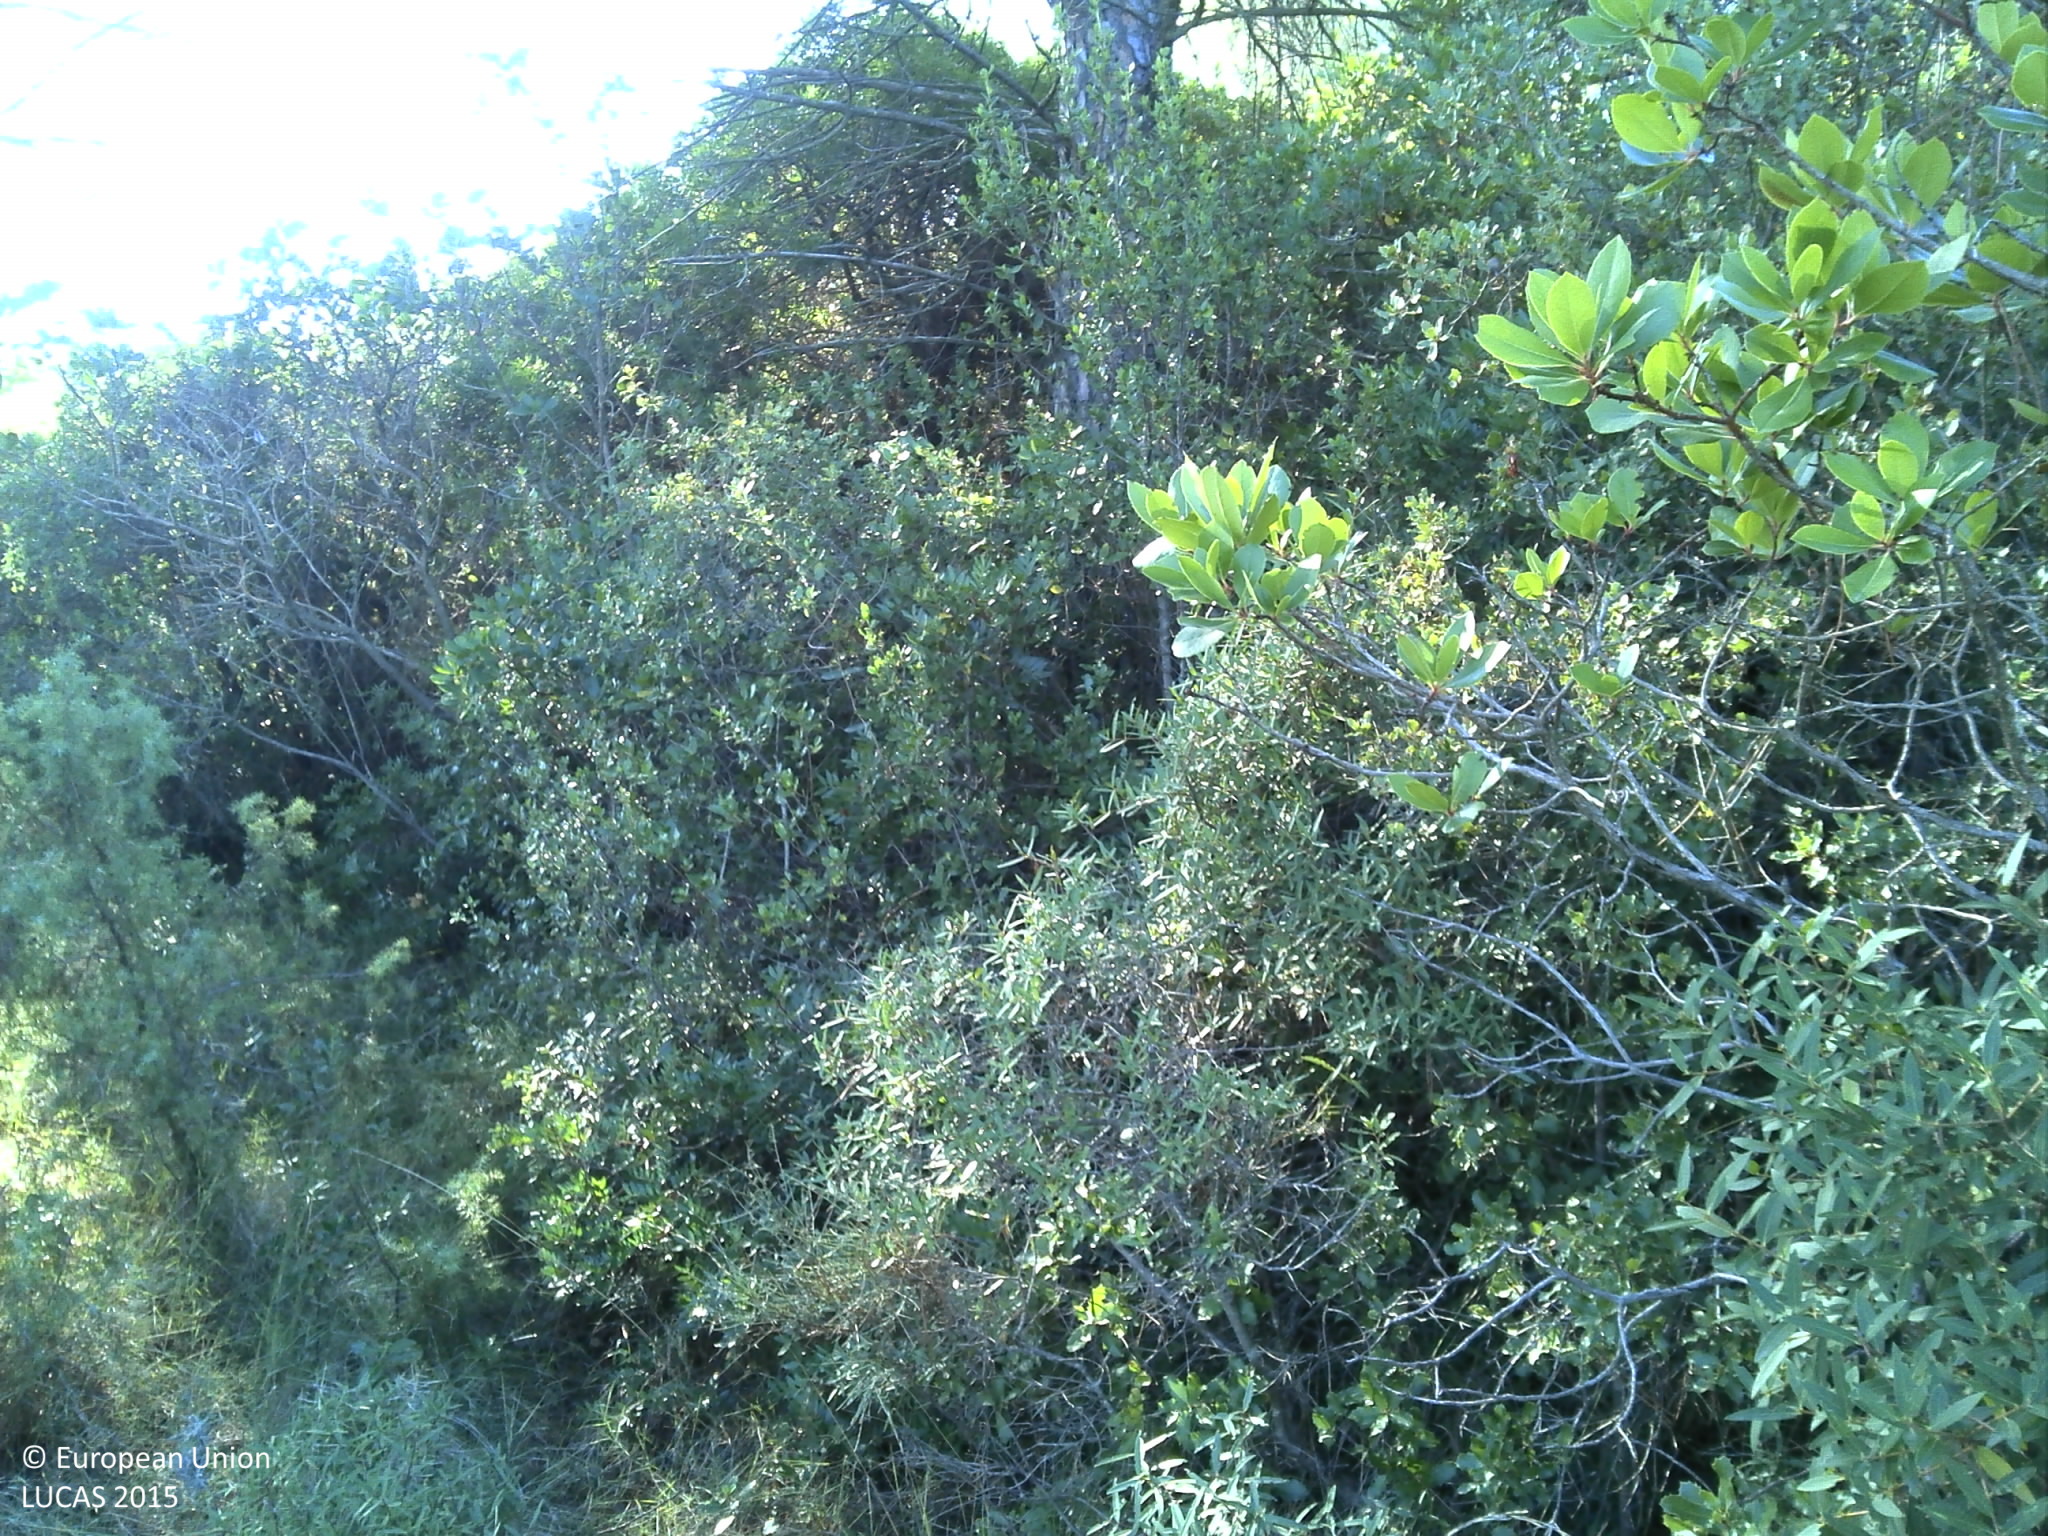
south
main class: Woodland
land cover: Pine dominated mixed woodland
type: coniferous forest of the mediterranean region
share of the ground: > 75 %
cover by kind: coniferous forest trees 45 %, broadleaved forest trees 30 %, shrubs 15 %, herbaceous plants 10 %
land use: Semi-natural and natural areas not in use
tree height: > 5 m
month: October
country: FR
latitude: 43.4903
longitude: 3.1458
